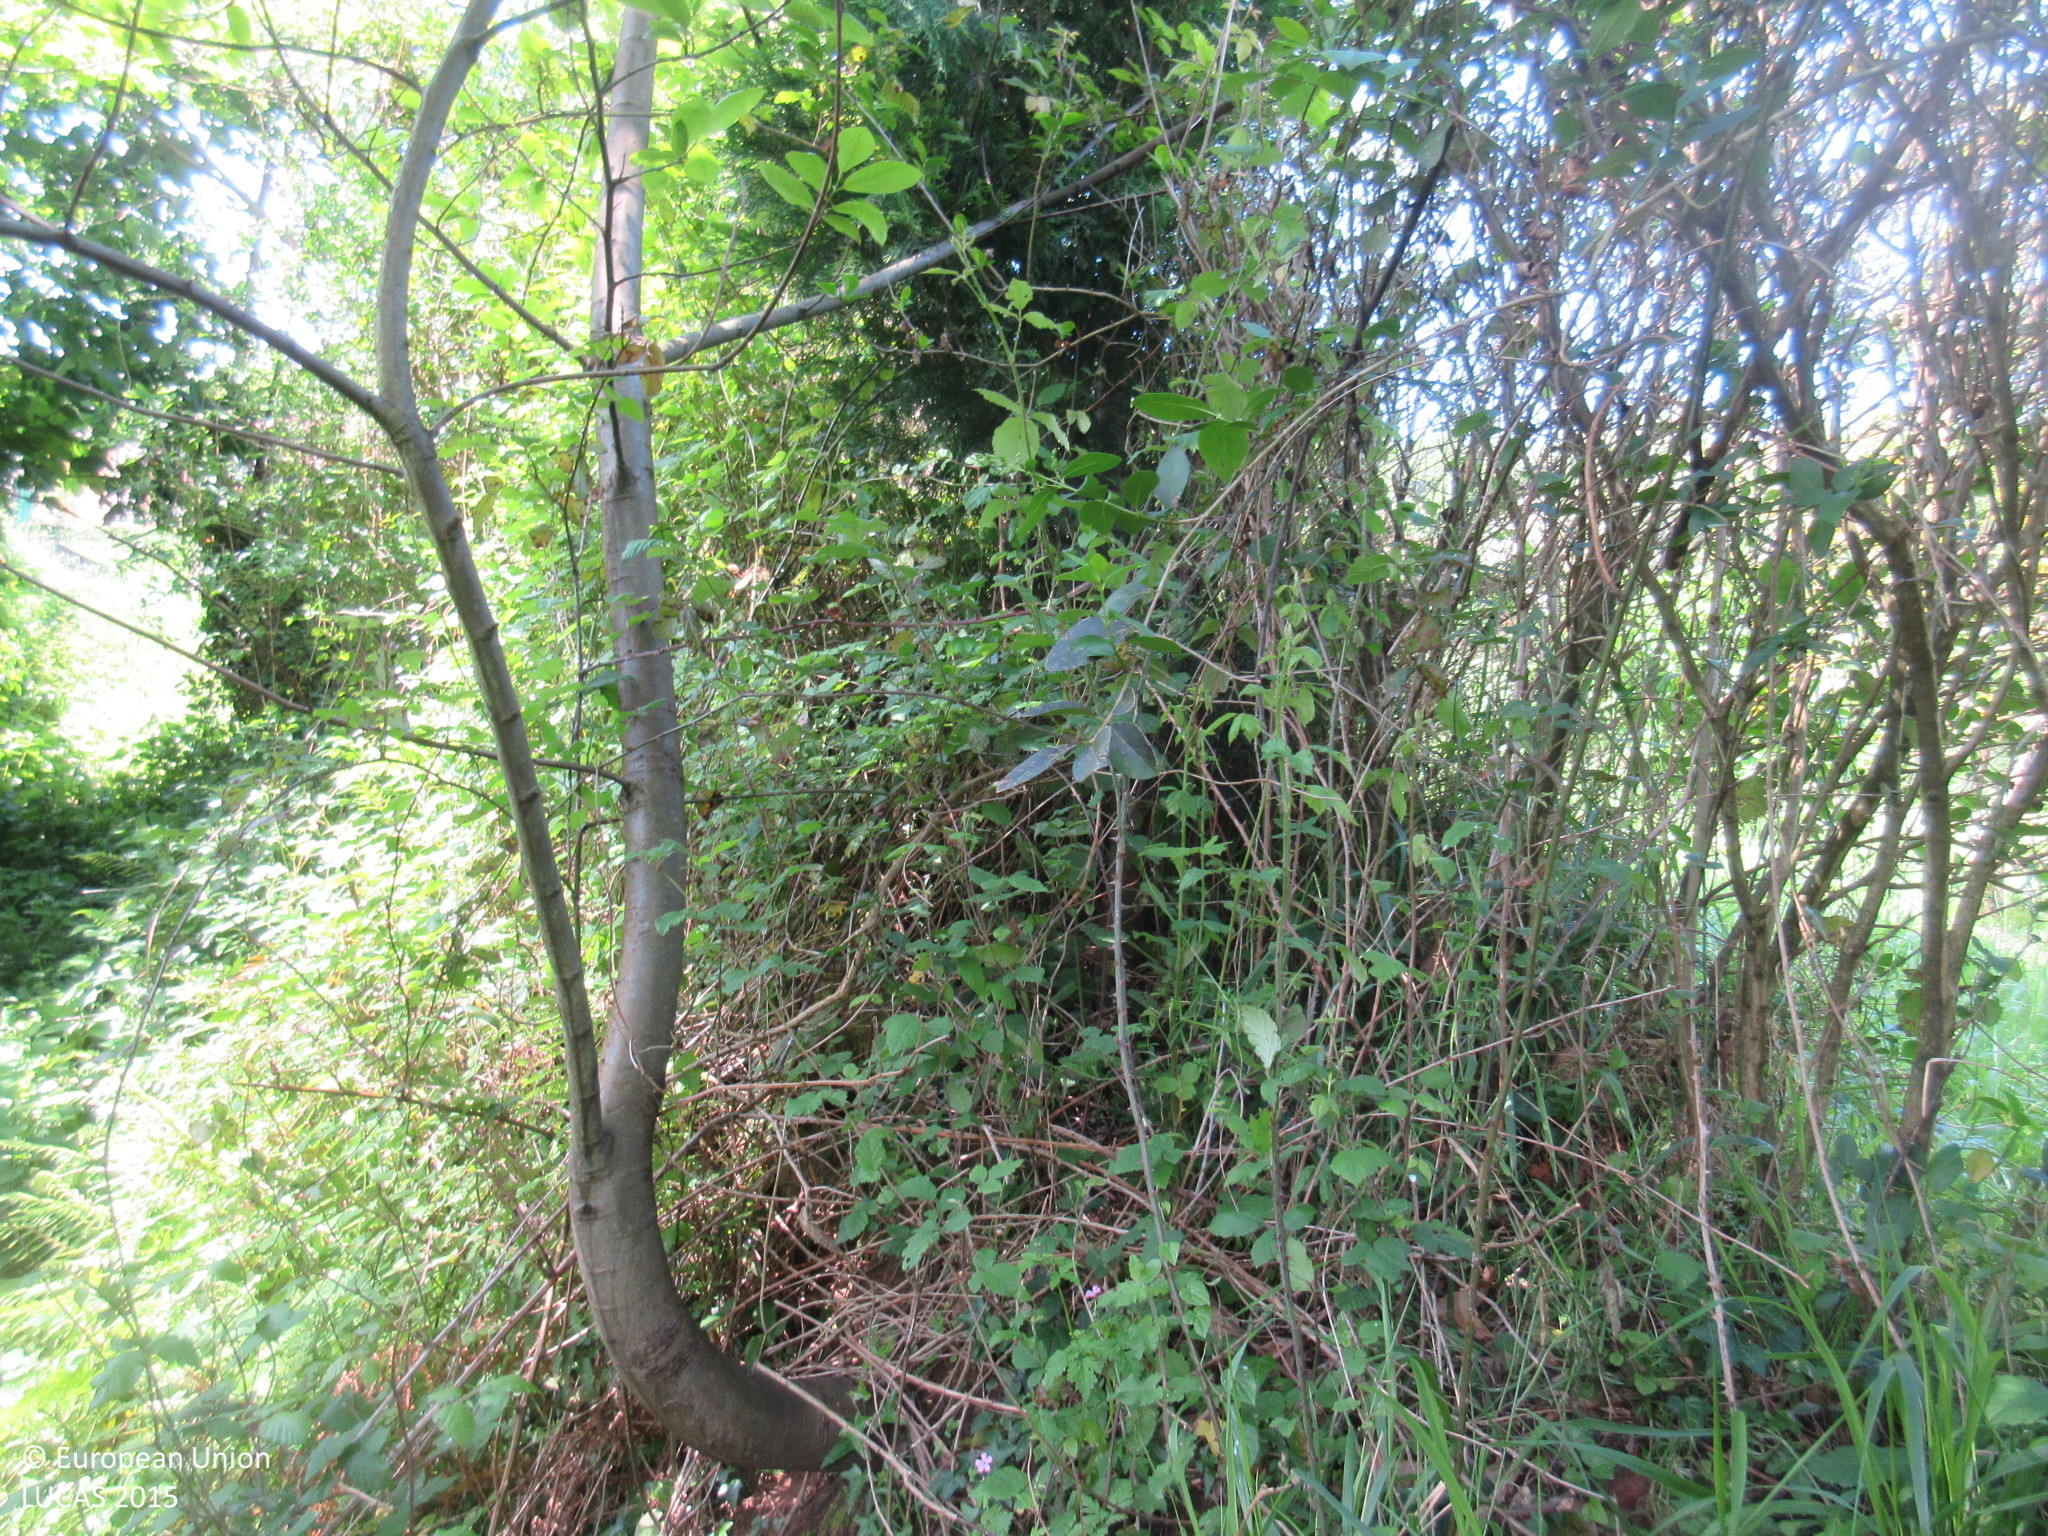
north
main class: Shrubland
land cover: Shrubland with sparse tree cover
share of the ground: > 75 %
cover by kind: shrubs 95 %, broadleaved forest trees 5 %
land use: Semi-natural and natural areas not in use
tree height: > 5 m
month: May
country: ES
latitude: 43.2807
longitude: -5.8982
